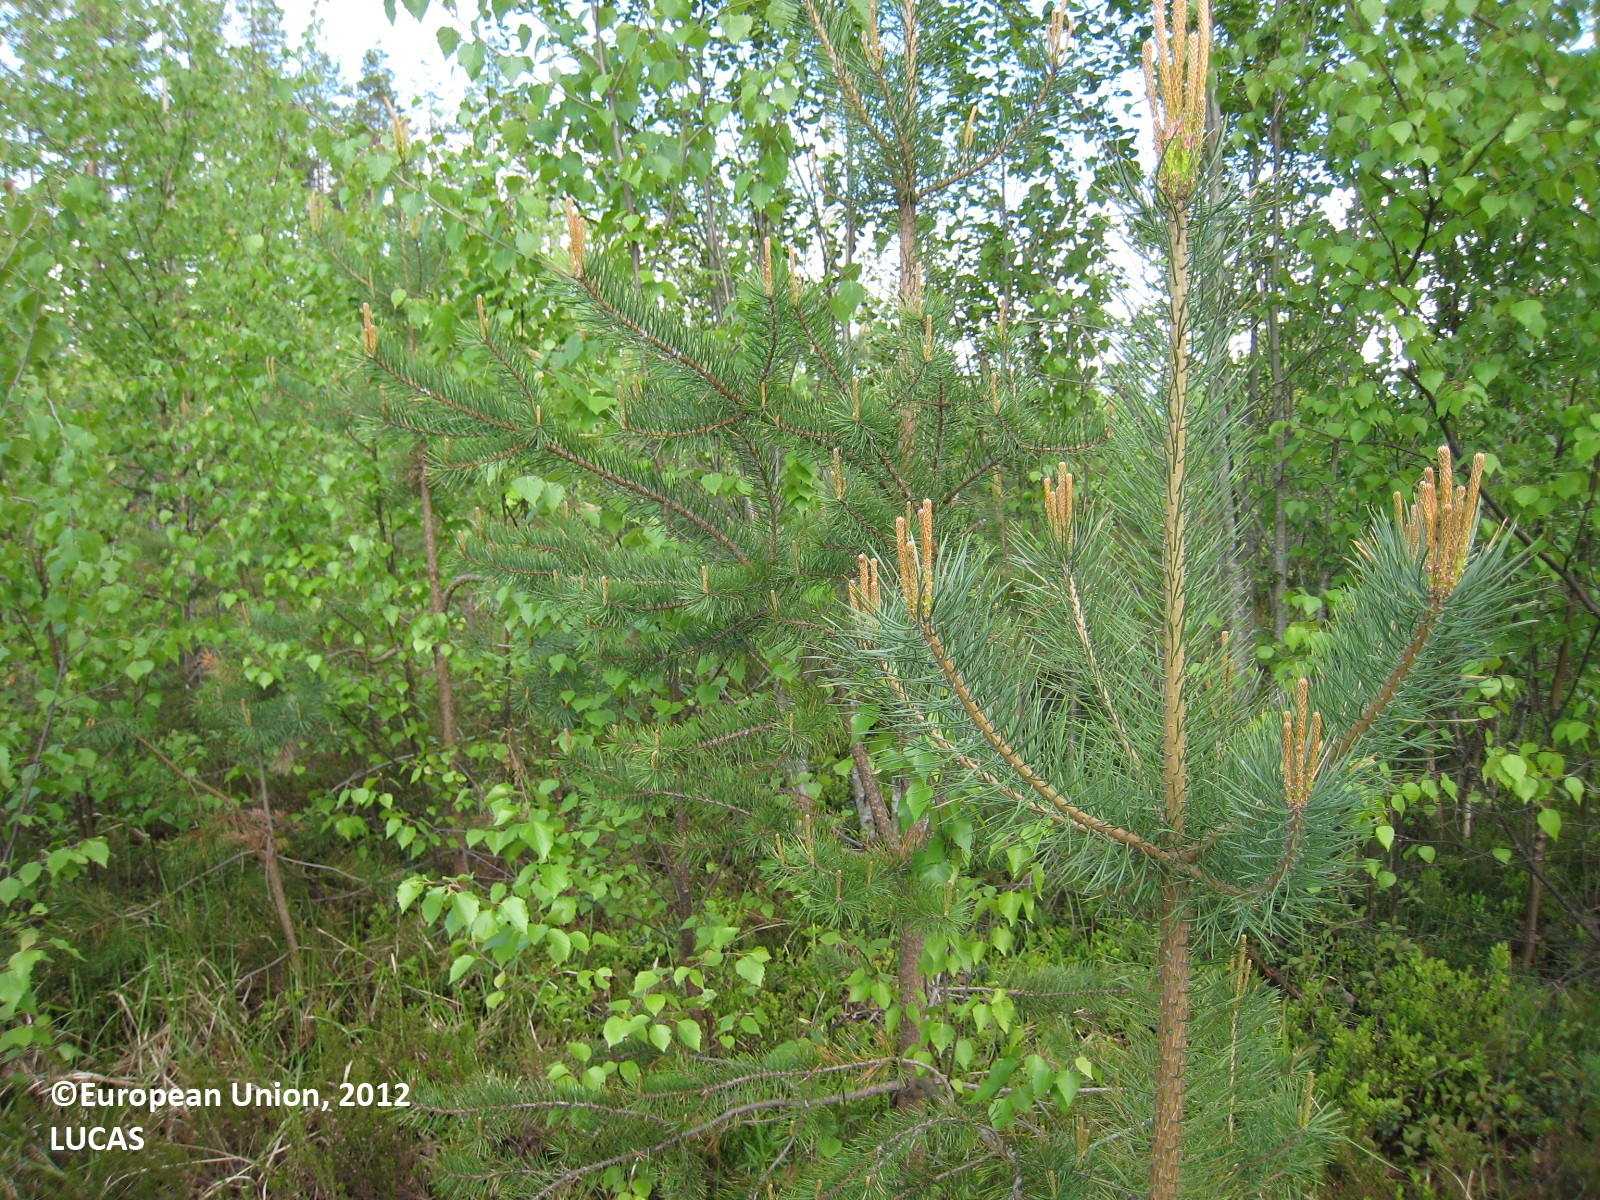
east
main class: Woodland
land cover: Pine dominated mixed woodland
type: boreal forest
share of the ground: 50 - 75 %
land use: Forestry
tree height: < 5 m
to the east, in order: Pine dominated mixed woodland; Other mixed woodland; Ditches and canals; Shruby margins; Tracks; Shrubland with sparse tree cover
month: June
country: FI
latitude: 62.7086
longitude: 25.6550
